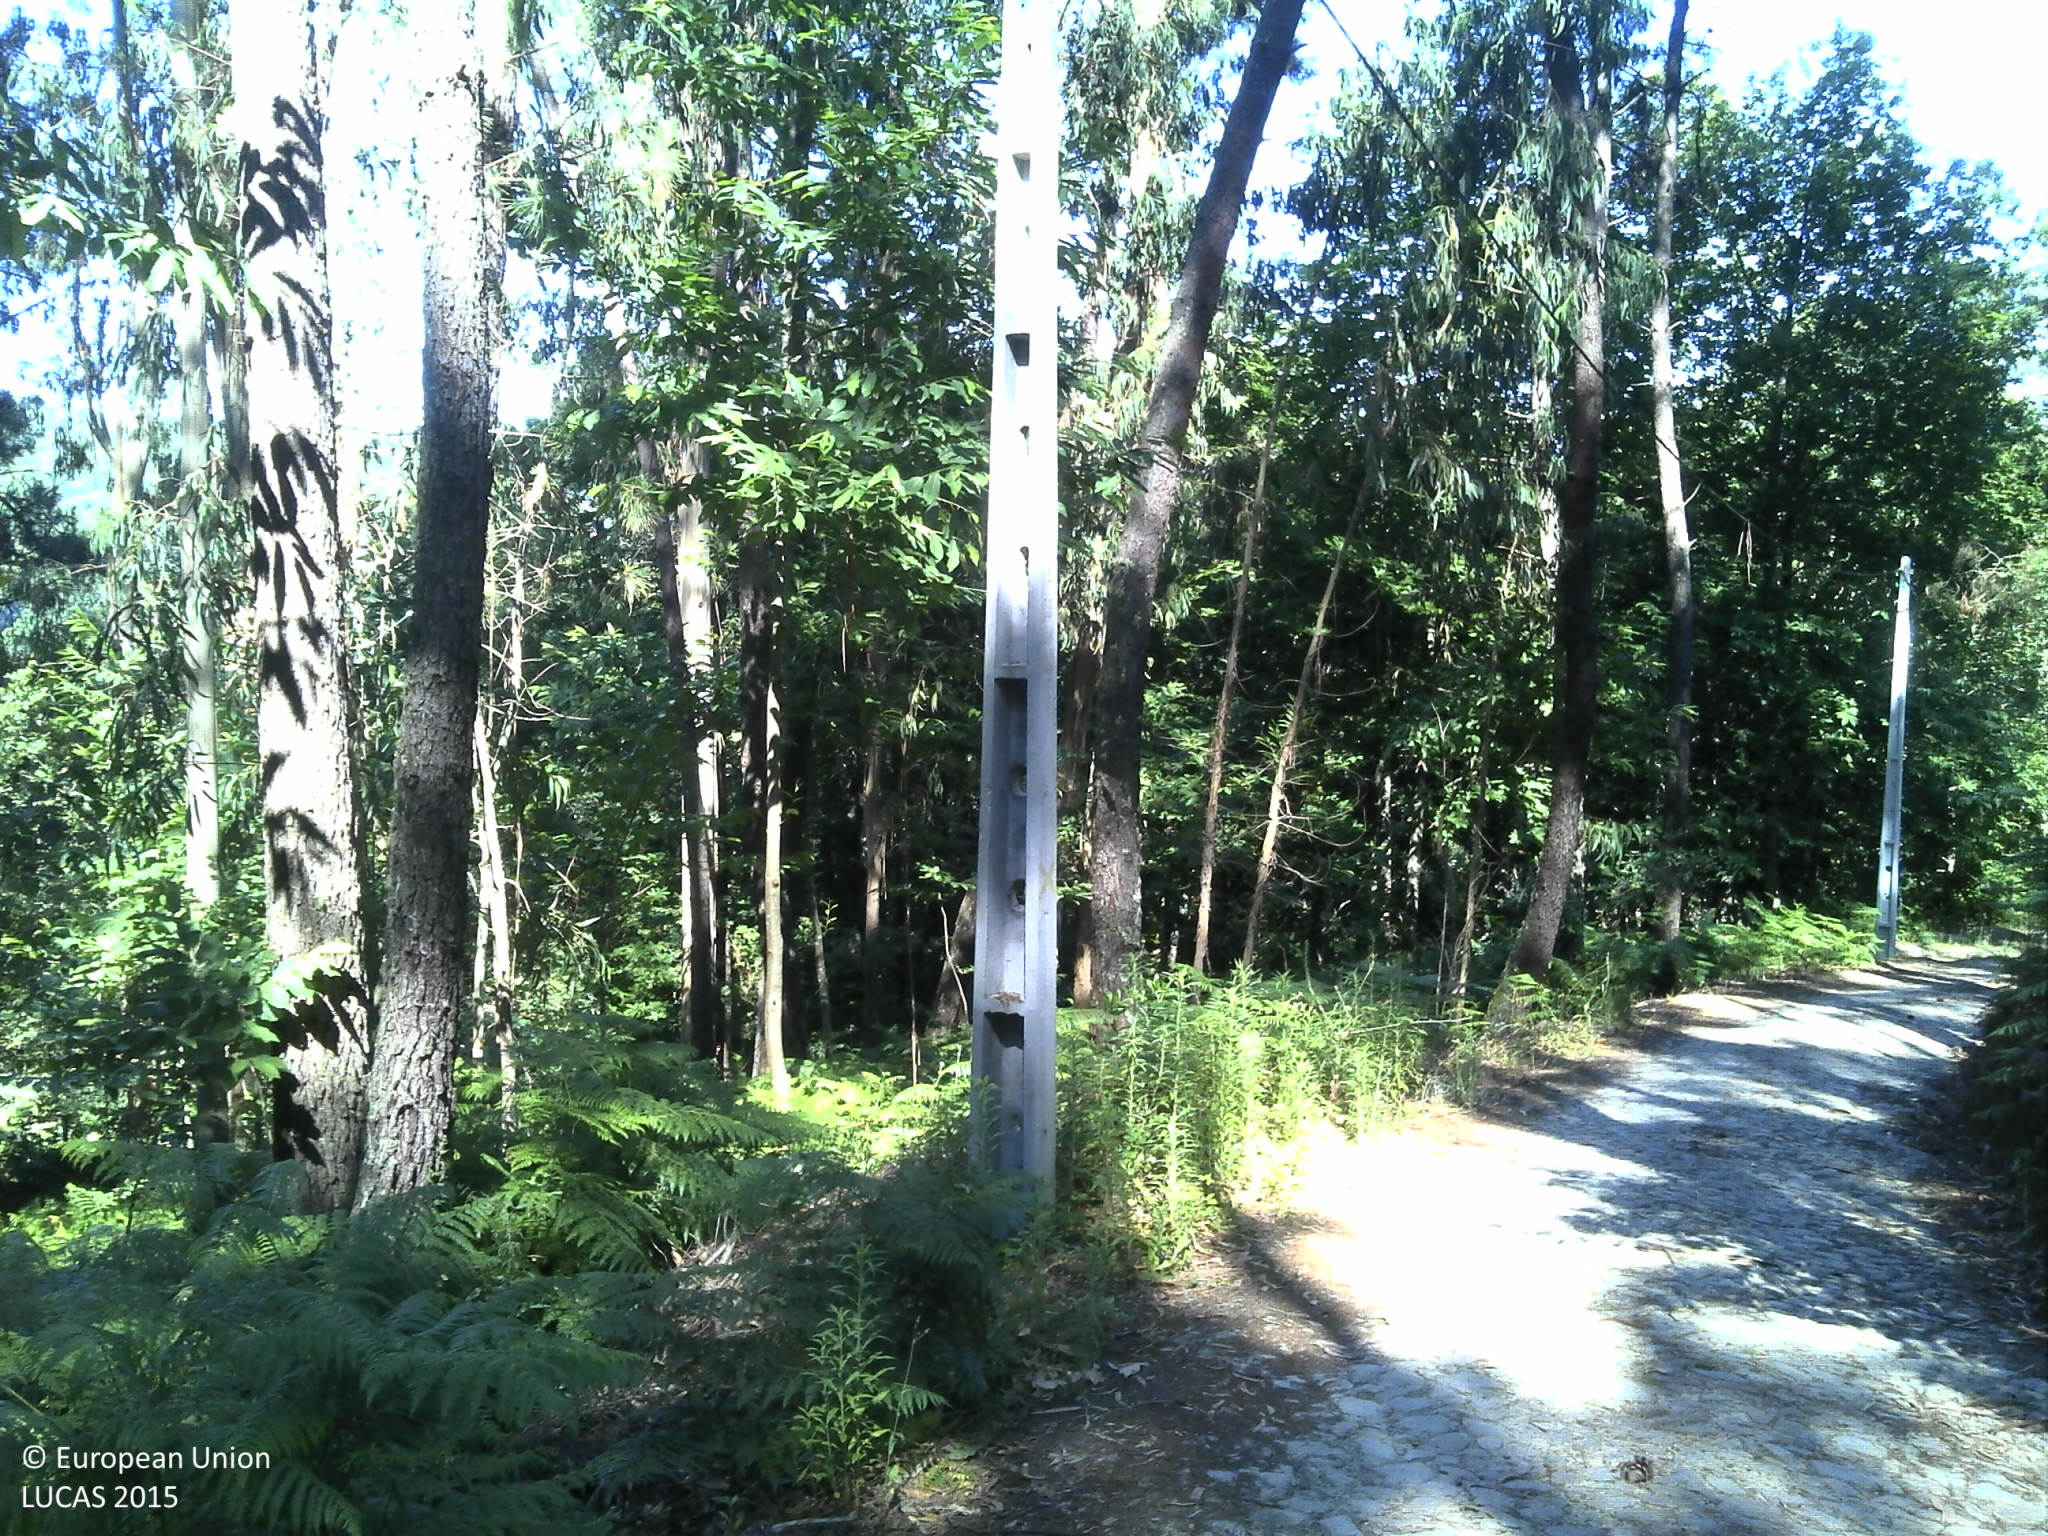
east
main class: Woodland
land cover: Pine dominated mixed woodland
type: coniferous forest of the mediterranean region
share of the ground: 50 - 75 %
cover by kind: coniferous forest trees 50 %, broadleaved forest trees 25 %, shrubs 10 %, herbaceous plants 10 %, unconsolidated bare surface 5 %
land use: Forestry
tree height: > 5 m
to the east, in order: Pine dominated mixed woodland; Broadleaved woodland; Other bare soil; Vineyards; Spontaneously vegetated surfaces; Vineyards; Other bare soil; Artificial constructions in urban areas; Arable land (only in case pi); Shruby margins; Arable land (only in case pi)
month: June
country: PT
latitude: 40.7400
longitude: -8.0465
